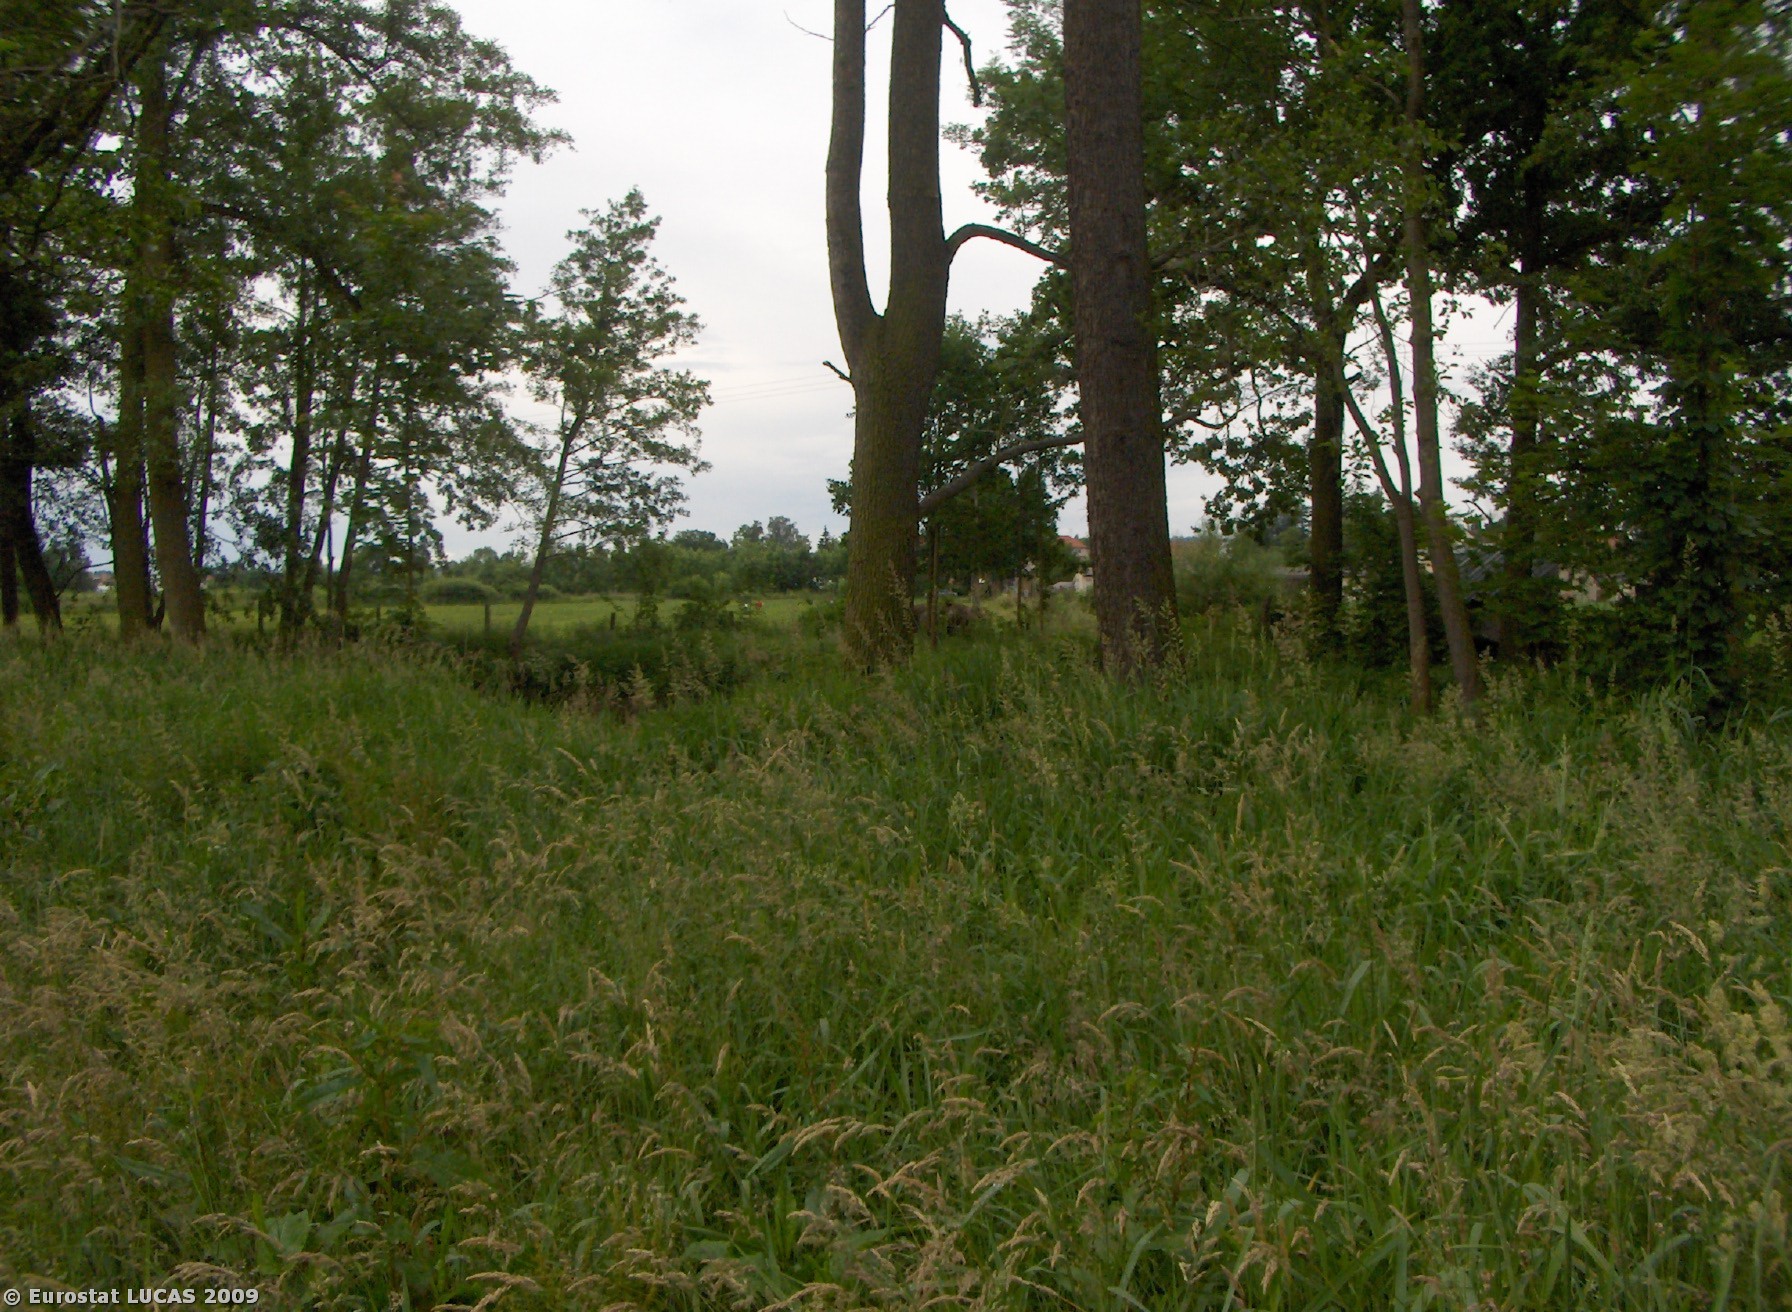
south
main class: Grassland
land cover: Grassland without tree/shrub cover
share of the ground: > 75 %
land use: Agriculture (excluding fallow land and kitchen gardens)
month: June
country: CZ
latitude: 49.1531
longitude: 14.1826
